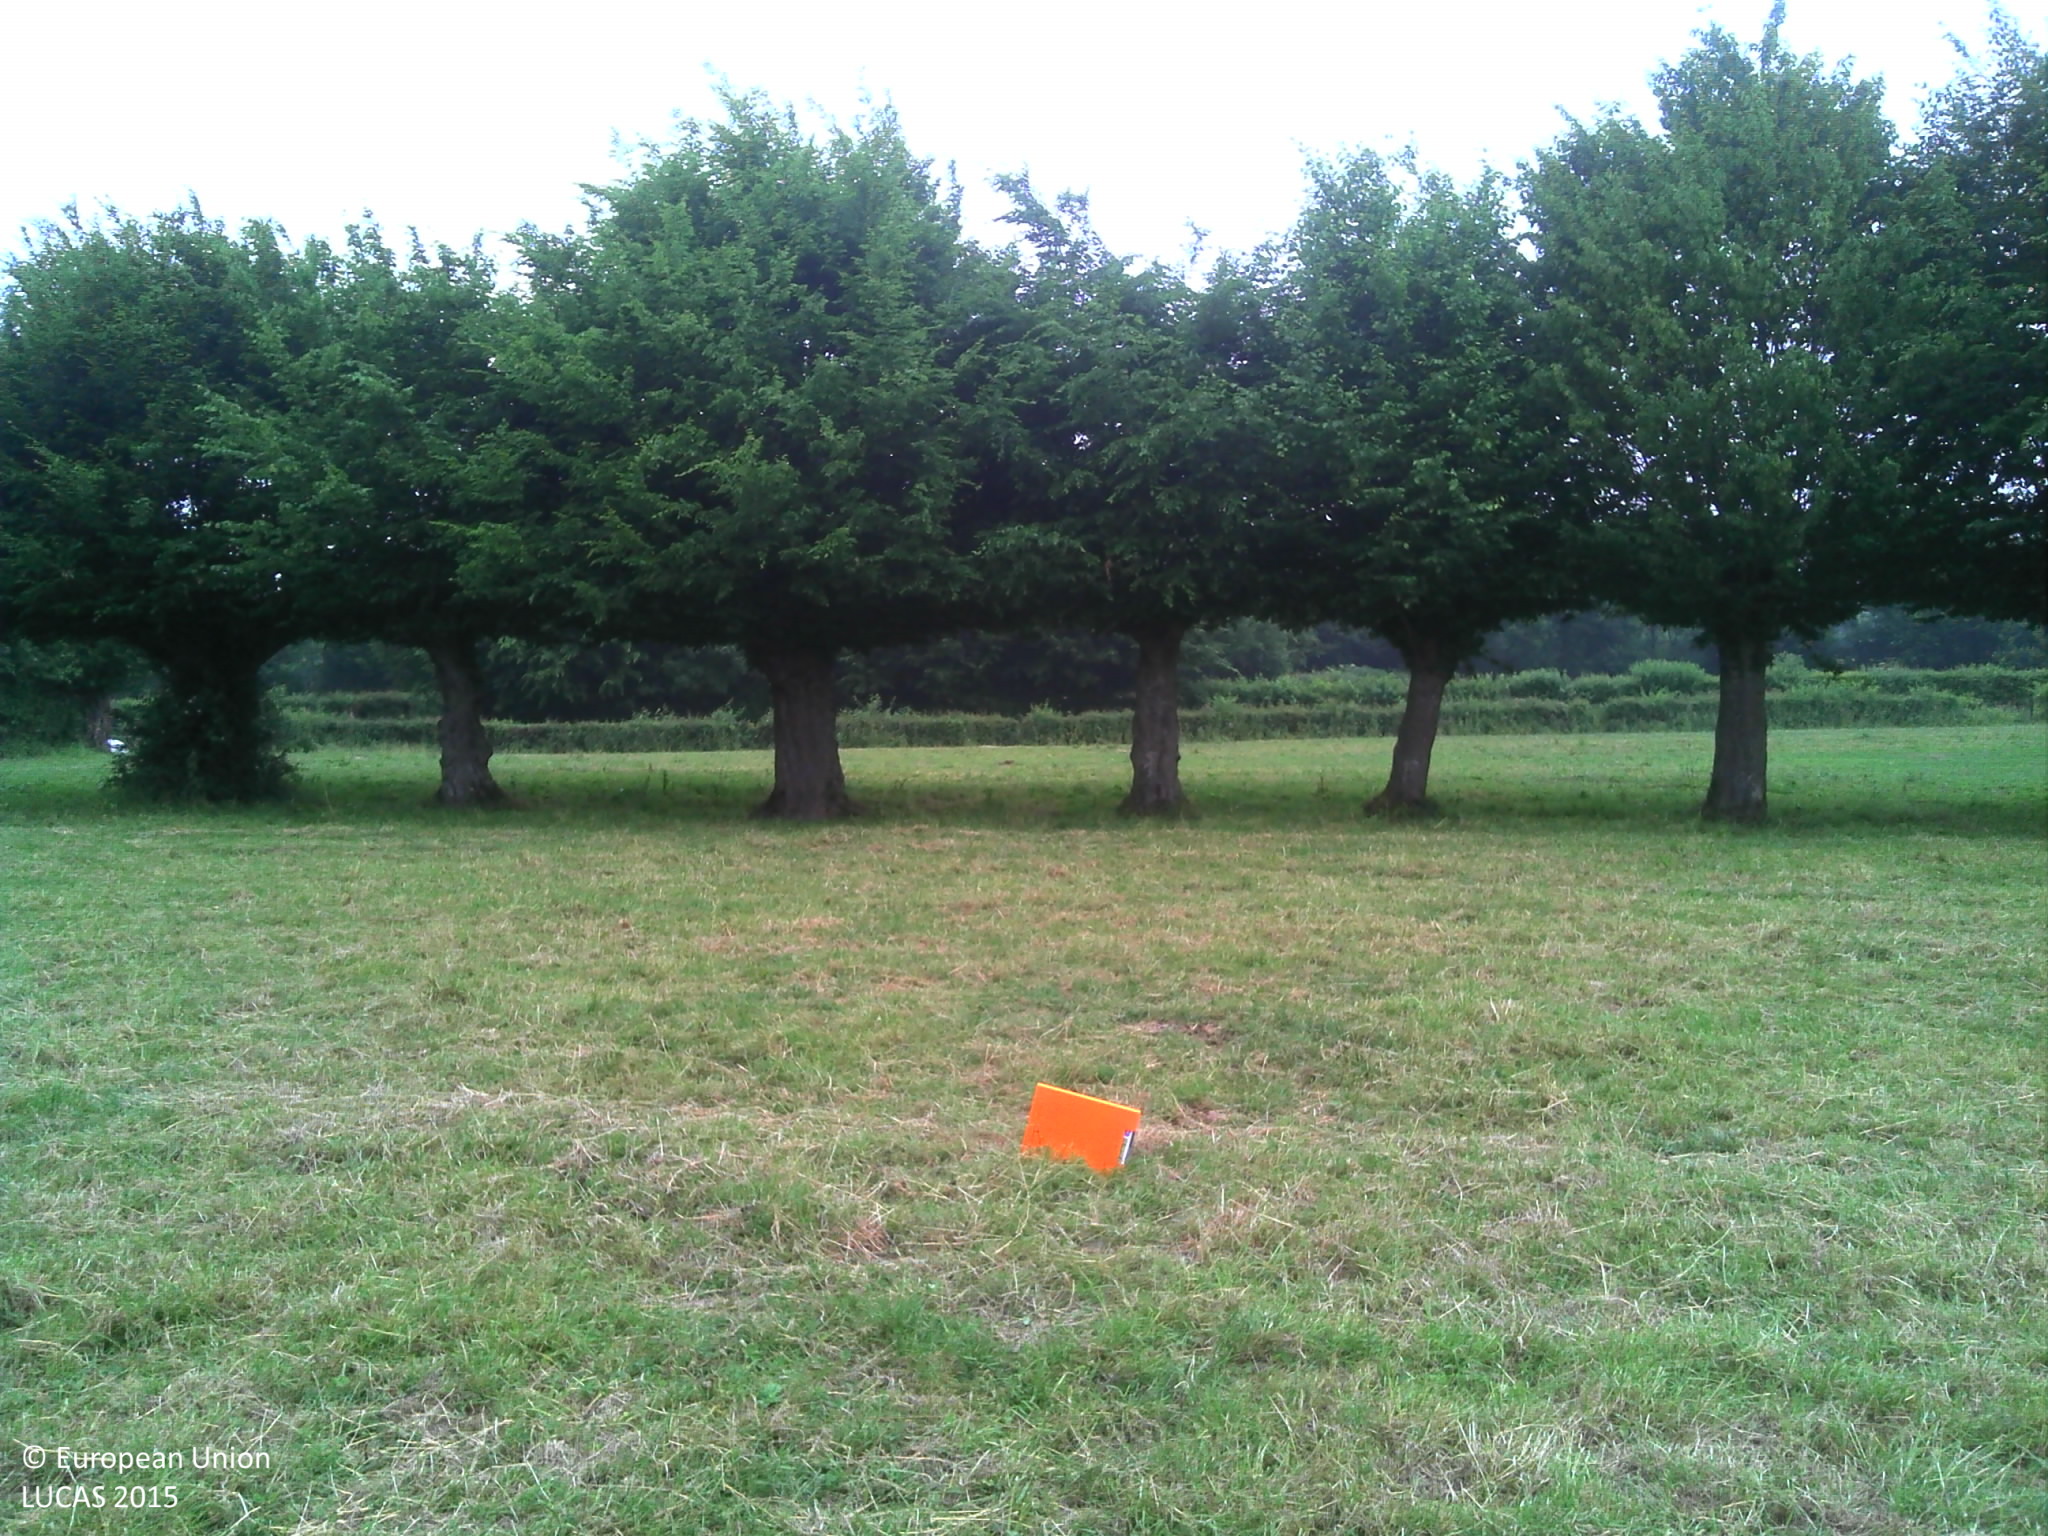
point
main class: Grassland
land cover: Grassland without tree/shrub cover
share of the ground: > 75 %
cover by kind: herbaceous plants 100 %
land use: Agriculture (excluding fallow land and kitchen gardens)
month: June
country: FR
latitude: 50.0072
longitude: 3.9805
